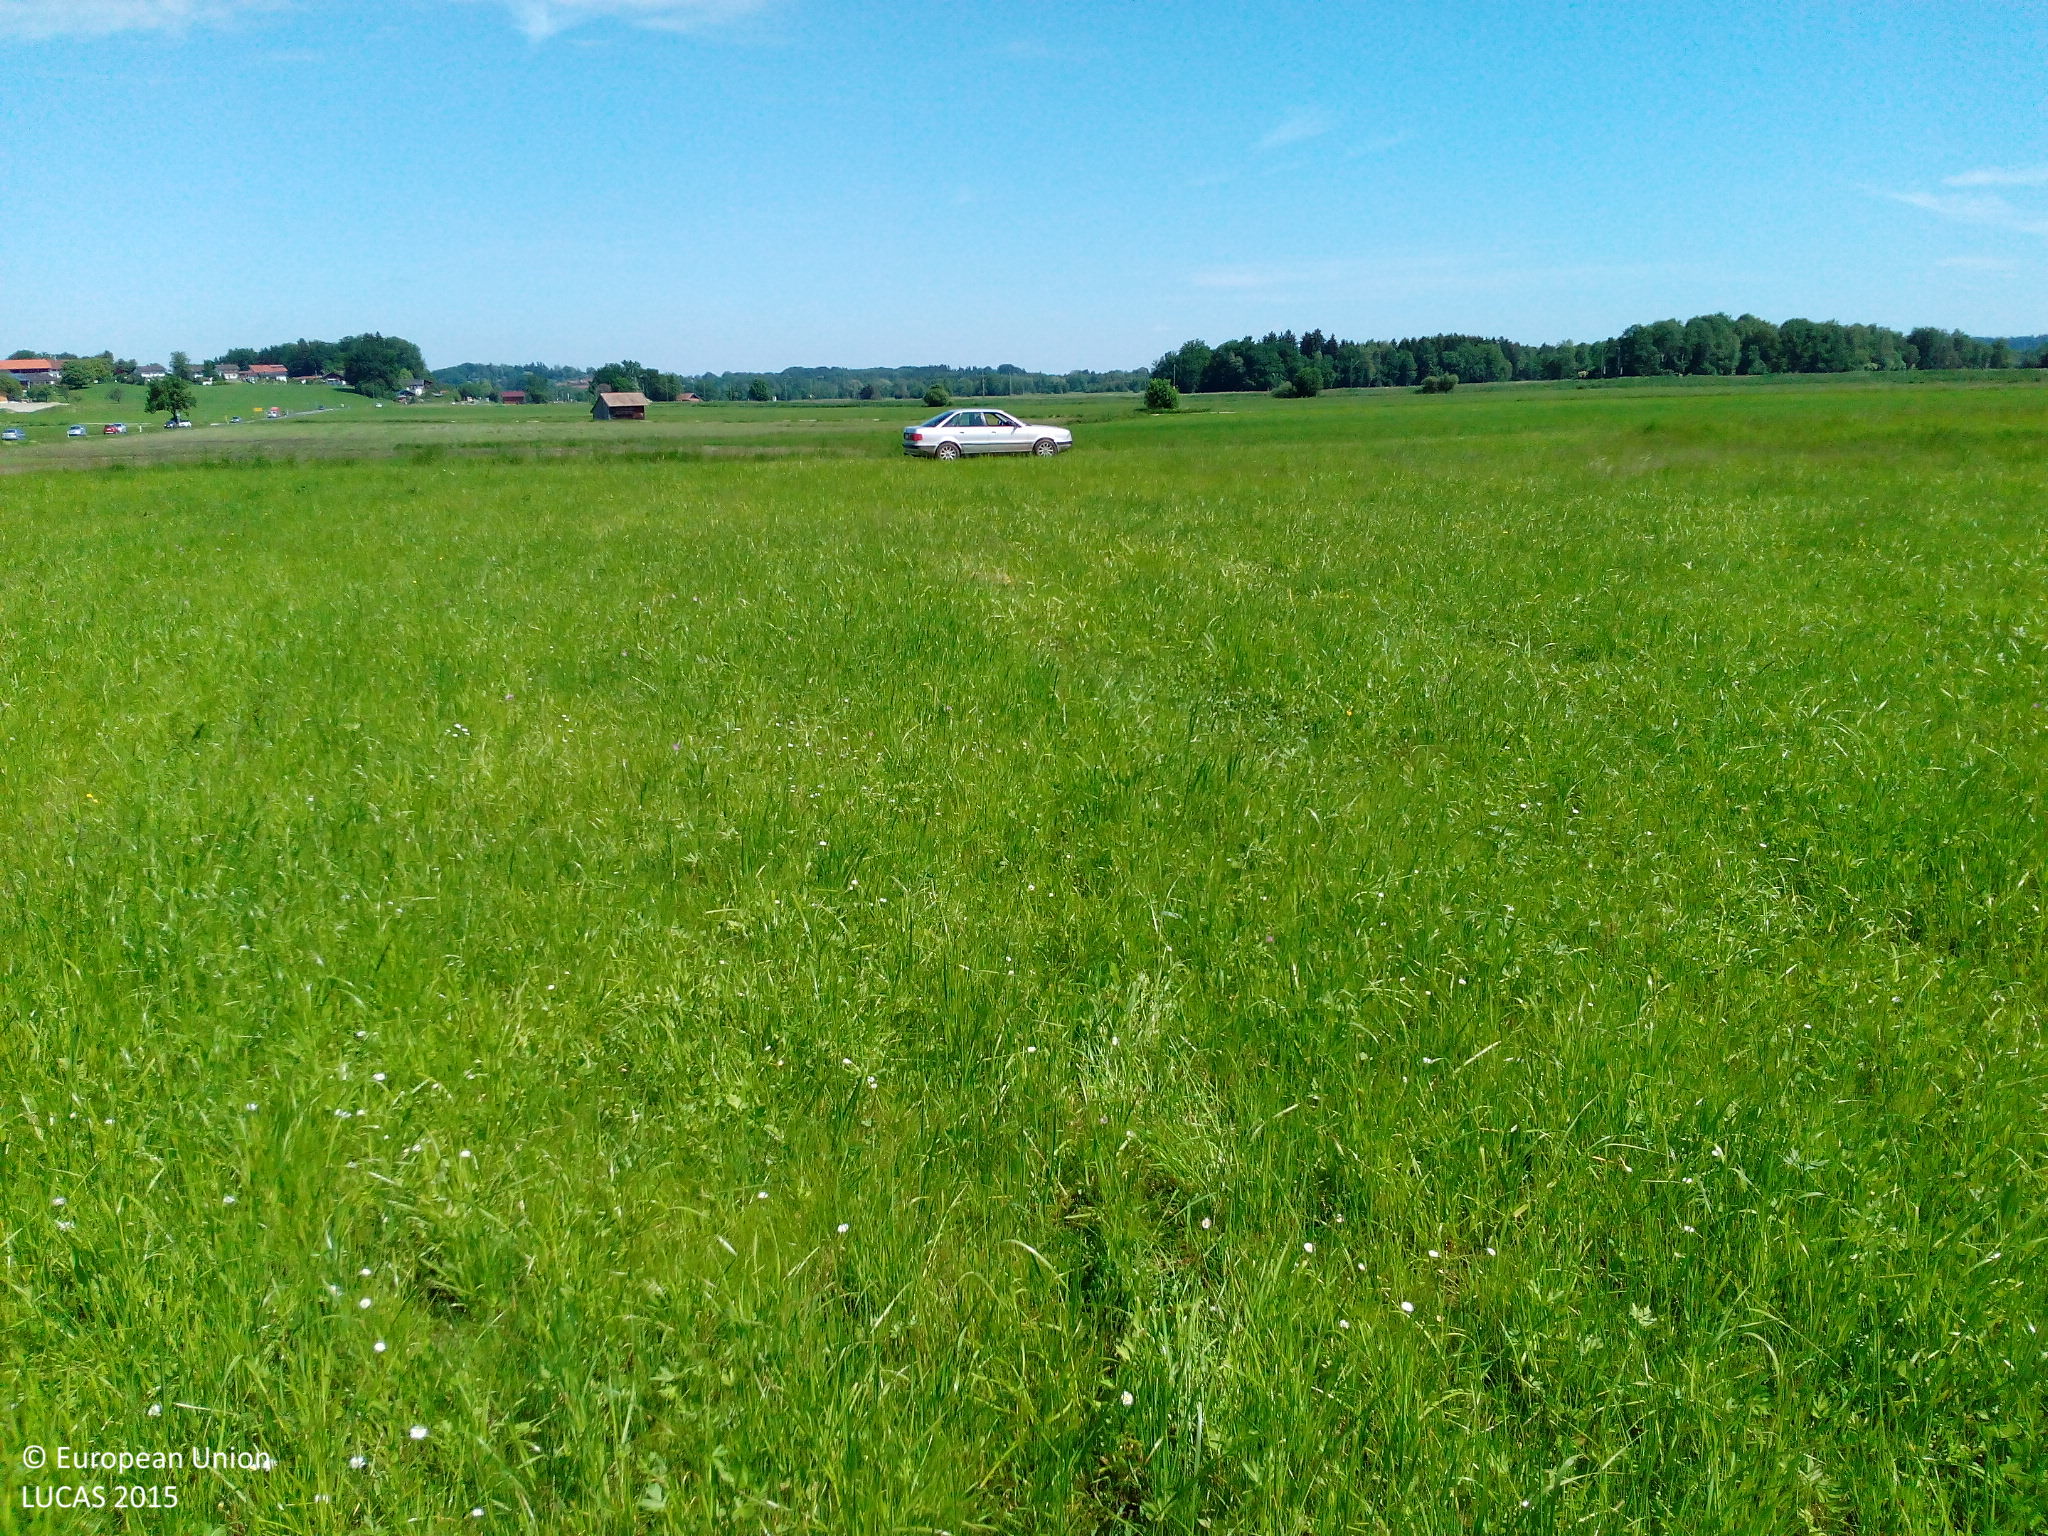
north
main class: Grassland
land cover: Grassland without tree/shrub cover
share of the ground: > 75 %
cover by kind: herbaceous plants 100 %
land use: Agriculture (excluding fallow land and kitchen gardens)
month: June
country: DE
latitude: 47.8202
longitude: 12.3627
